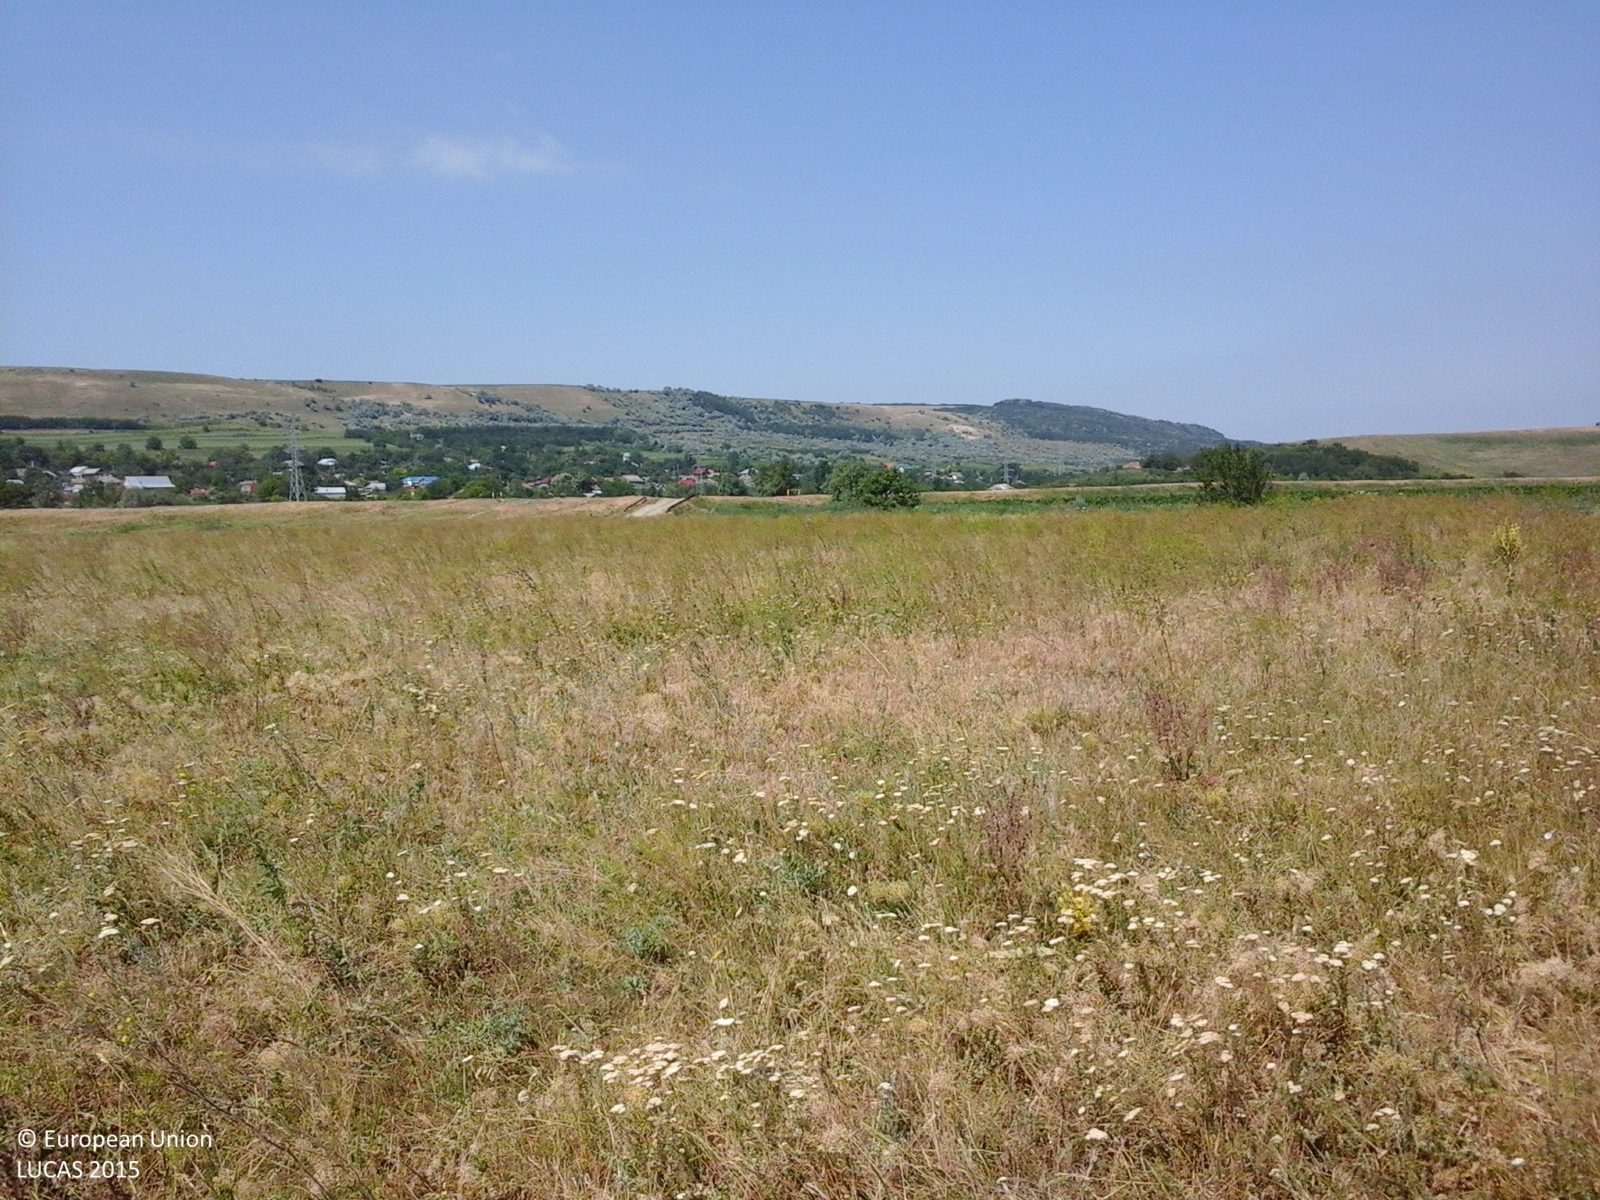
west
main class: Grassland
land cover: Grassland without tree/shrub cover
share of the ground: > 75 %
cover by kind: herbaceous plants 100 %
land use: Agriculture (excluding fallow land and kitchen gardens)
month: June
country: RO
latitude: 46.9185
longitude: 28.0558
